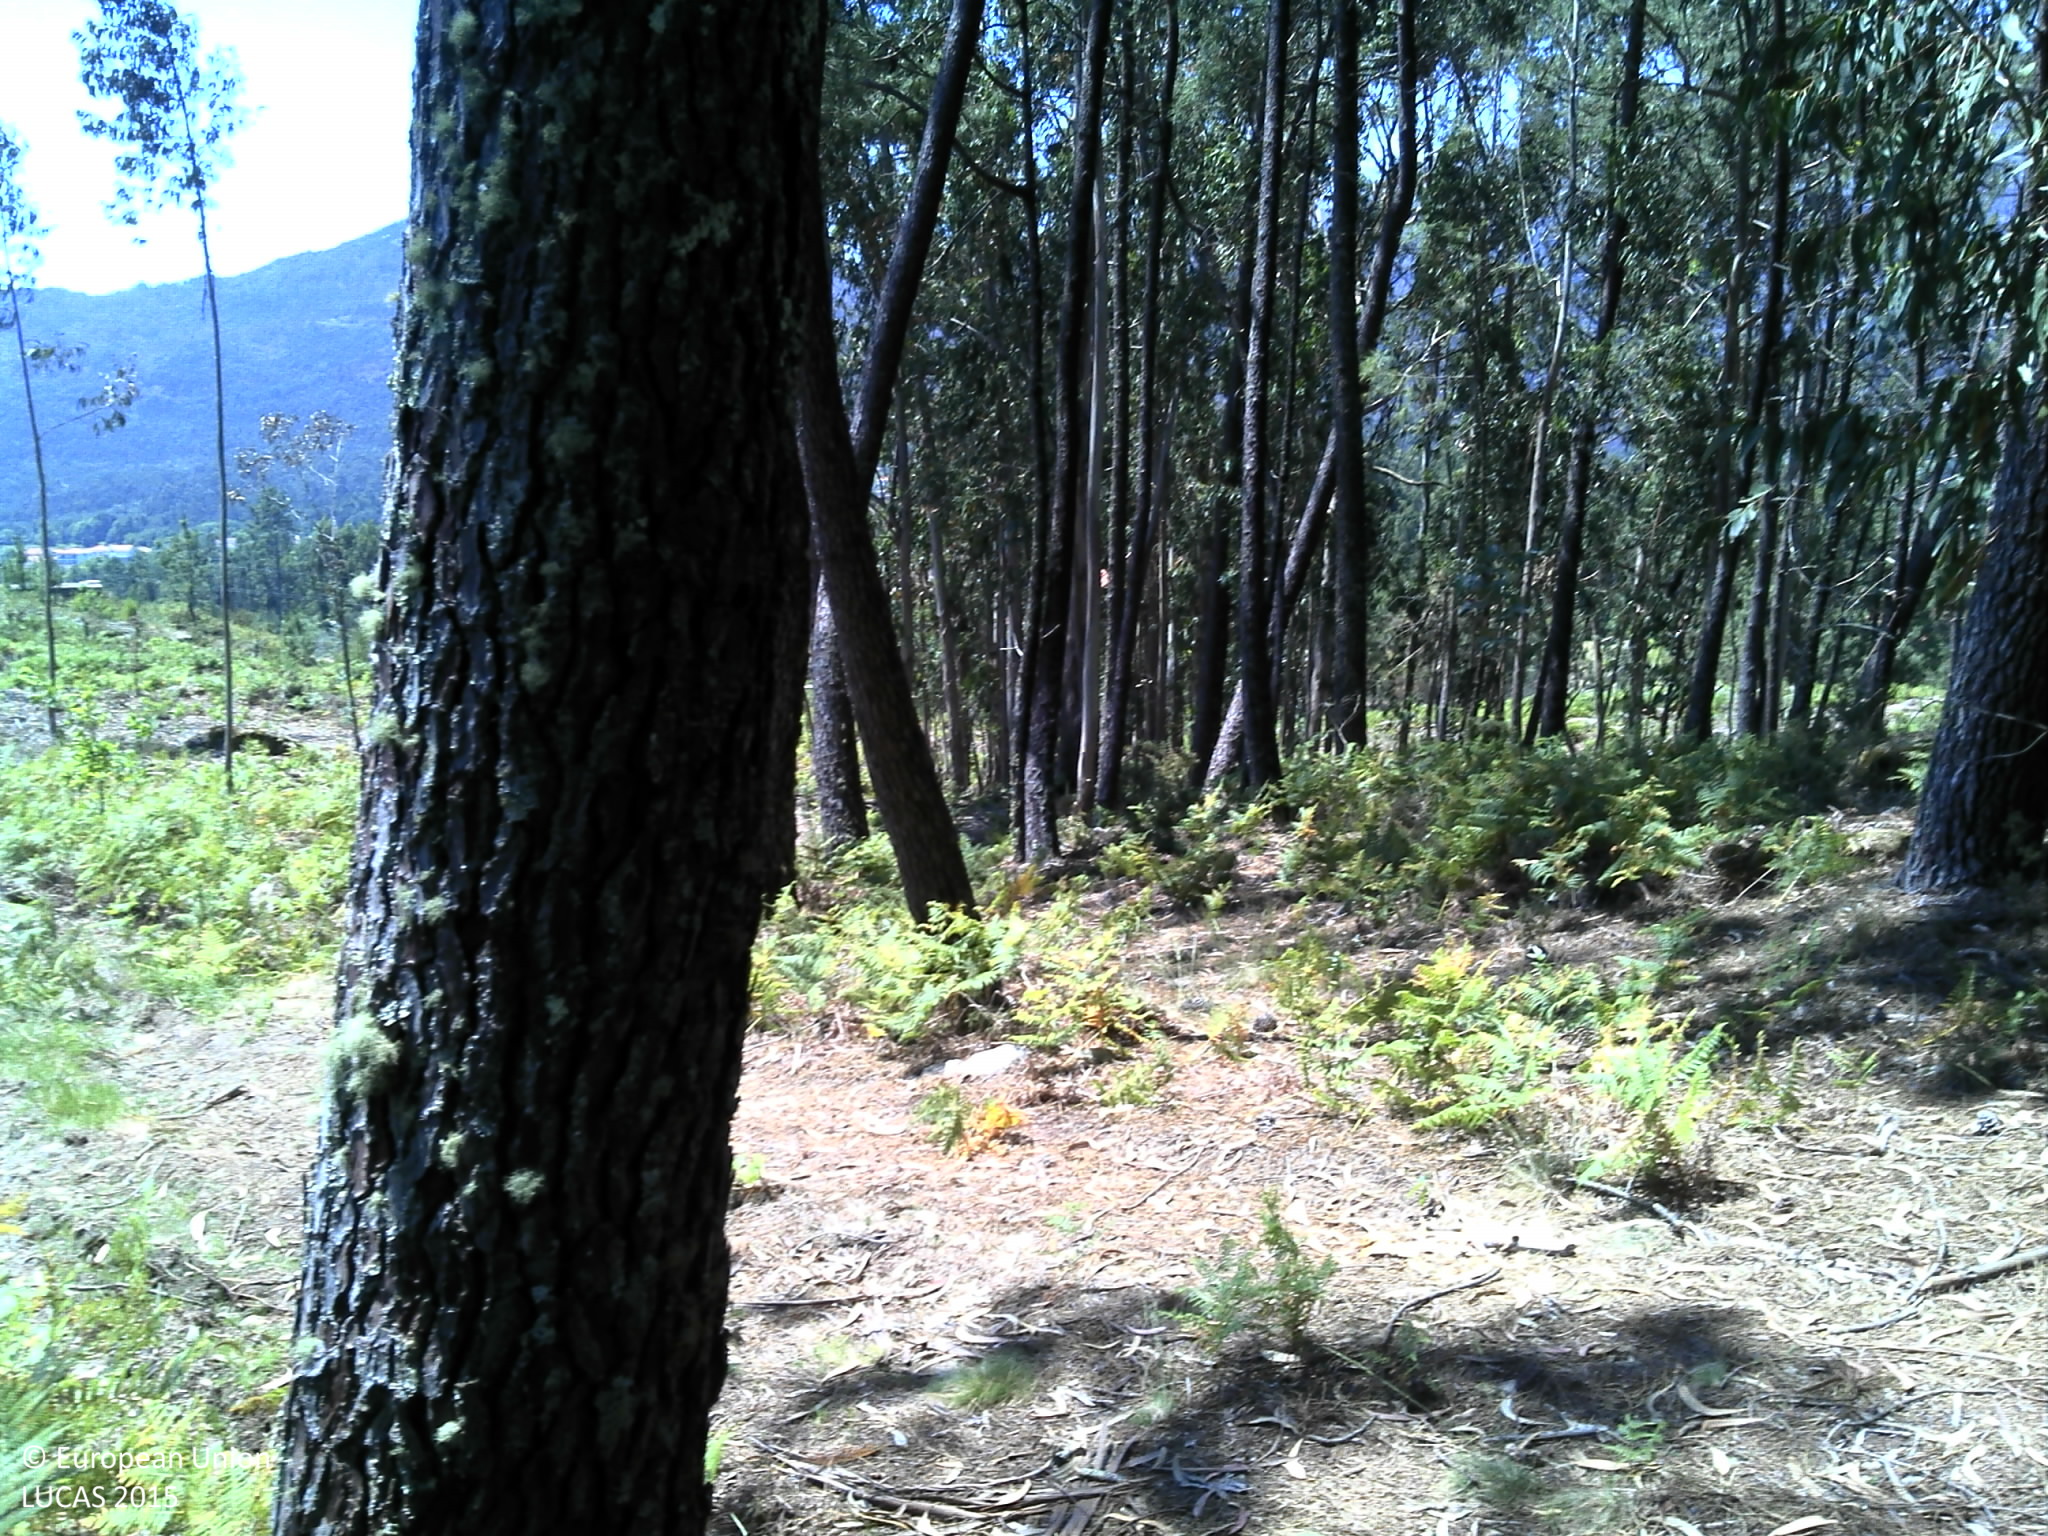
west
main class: Woodland
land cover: Pine dominated mixed woodland
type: coniferous forest of the mediterranean region
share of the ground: 50 - 75 %
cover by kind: coniferous forest trees 75 %, broadleaved forest trees 25 %
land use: Forestry
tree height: > 5 m
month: May
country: PT
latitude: 41.7935
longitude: -8.6363
